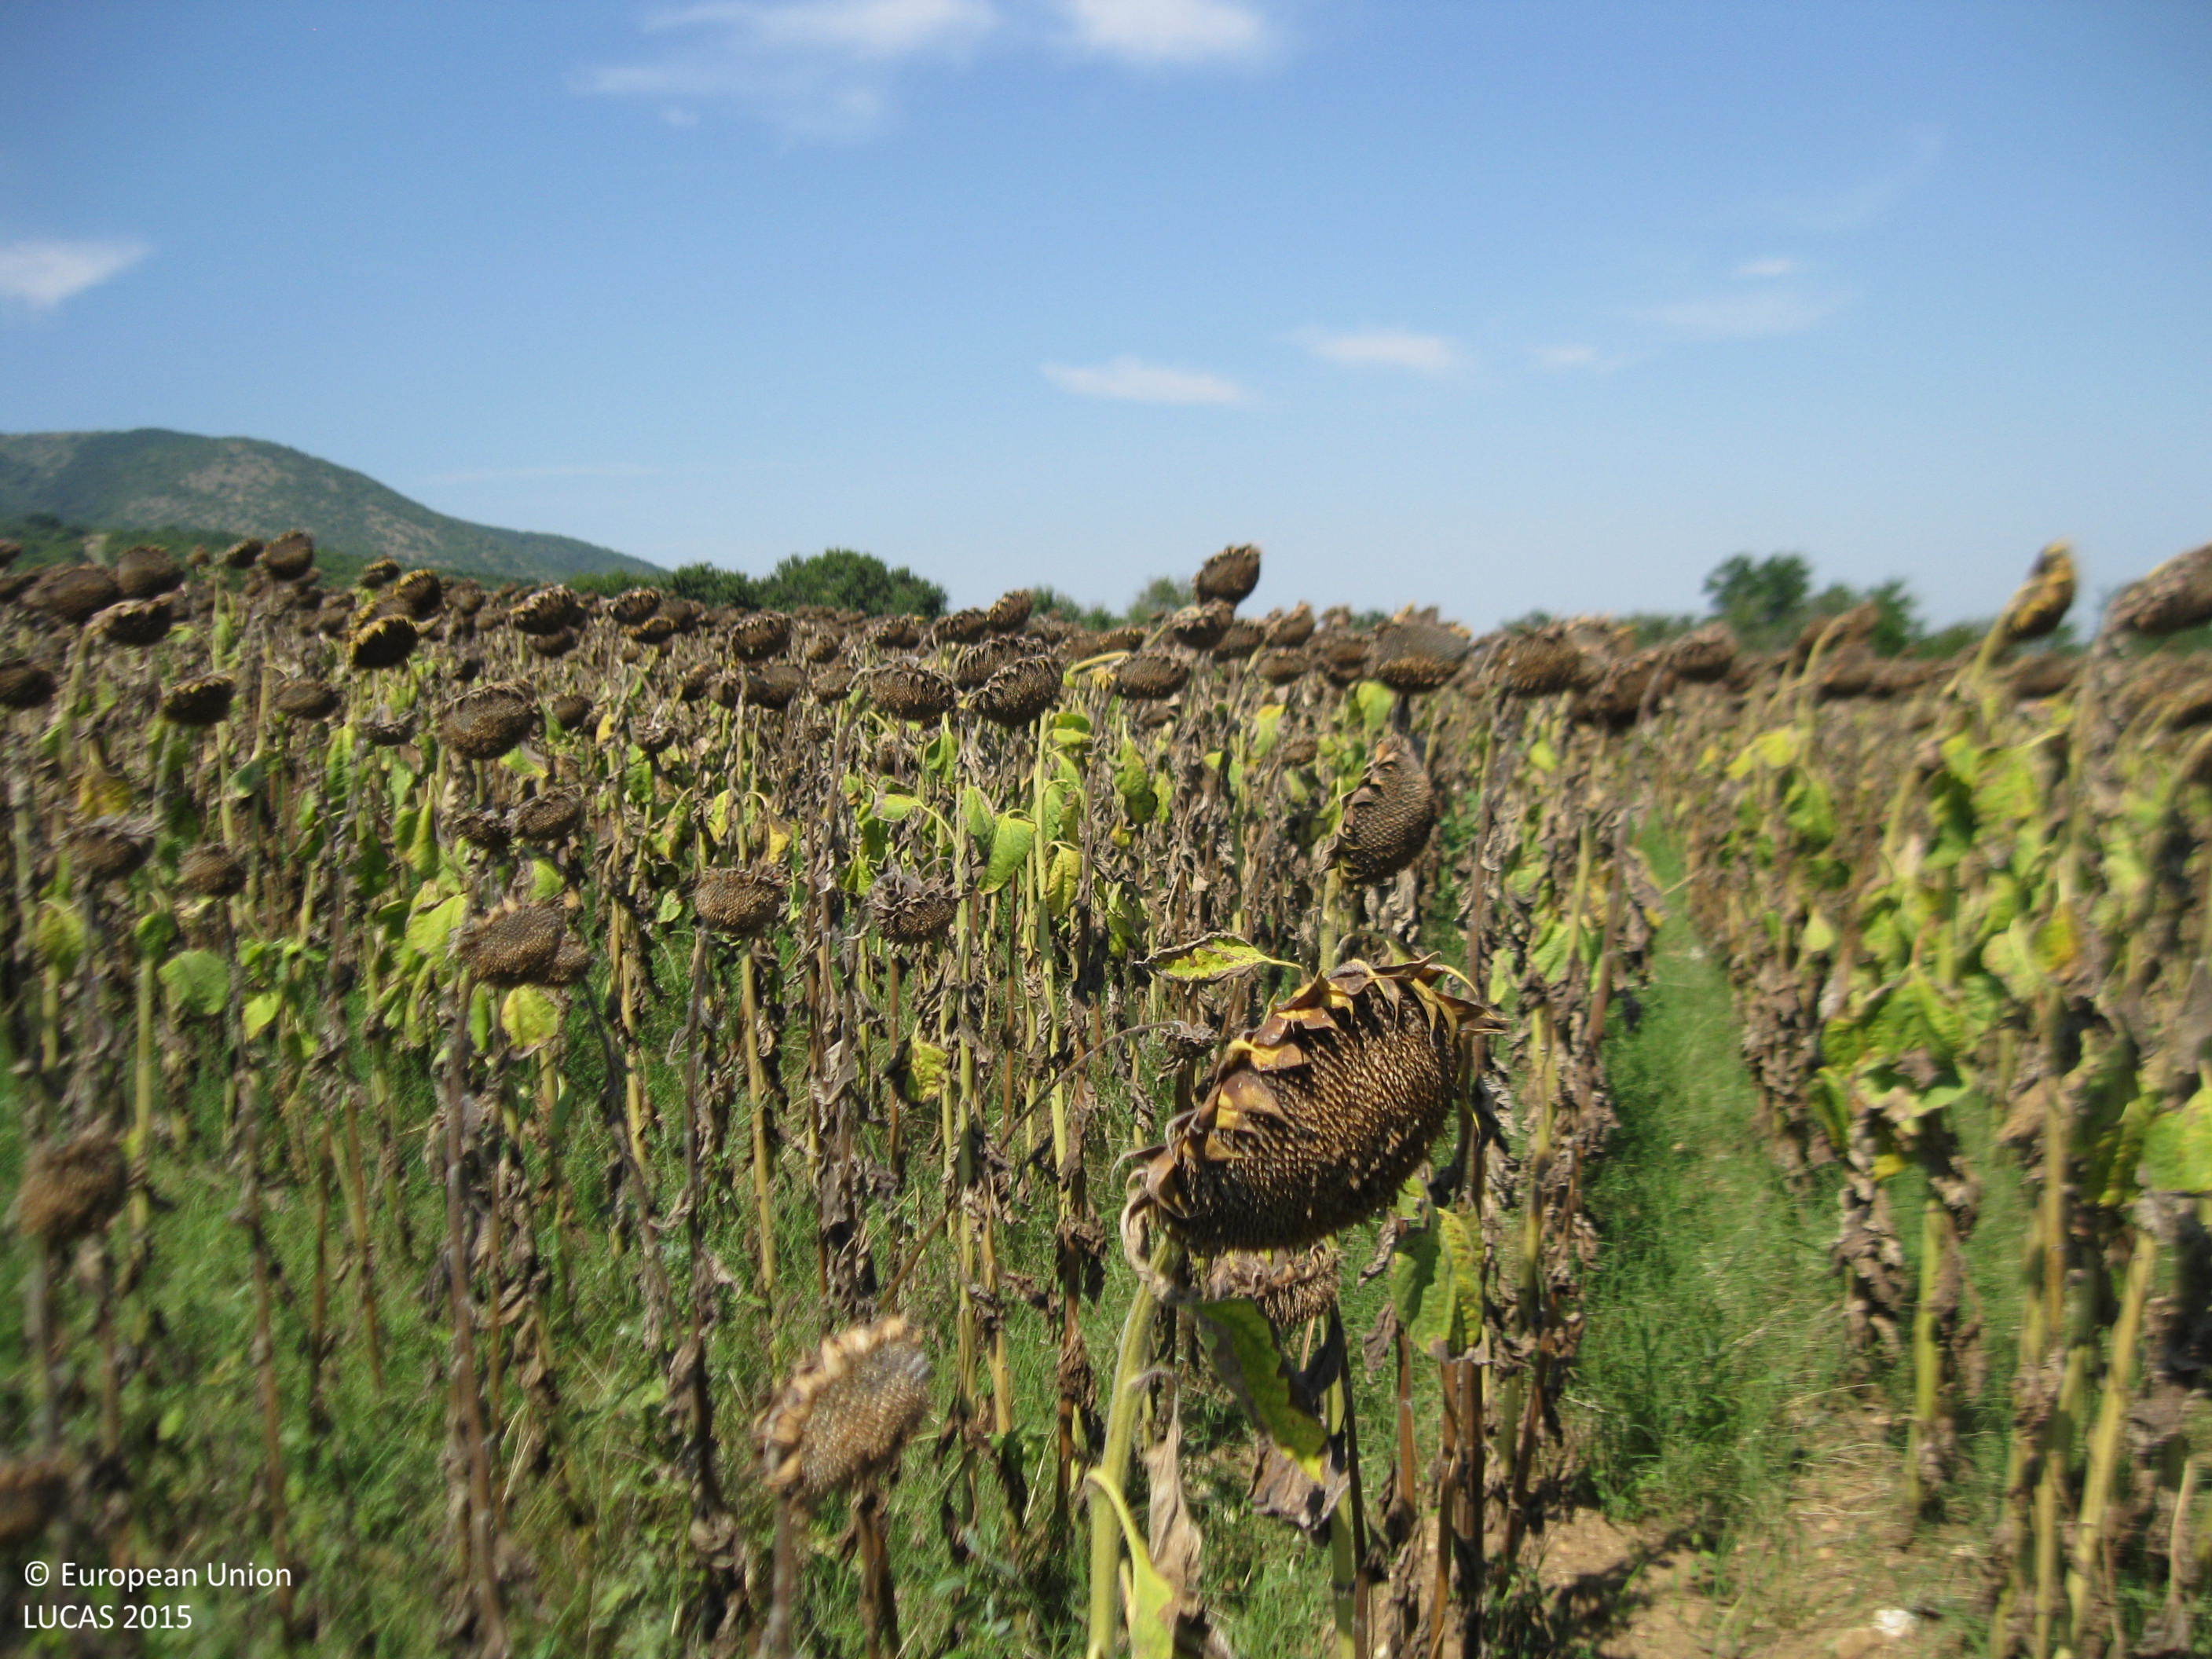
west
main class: Cropland
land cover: Sunflower
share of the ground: > 75 %
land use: Agriculture (excluding fallow land and kitchen gardens)
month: August
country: BG
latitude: 41.9585
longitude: 24.9532
